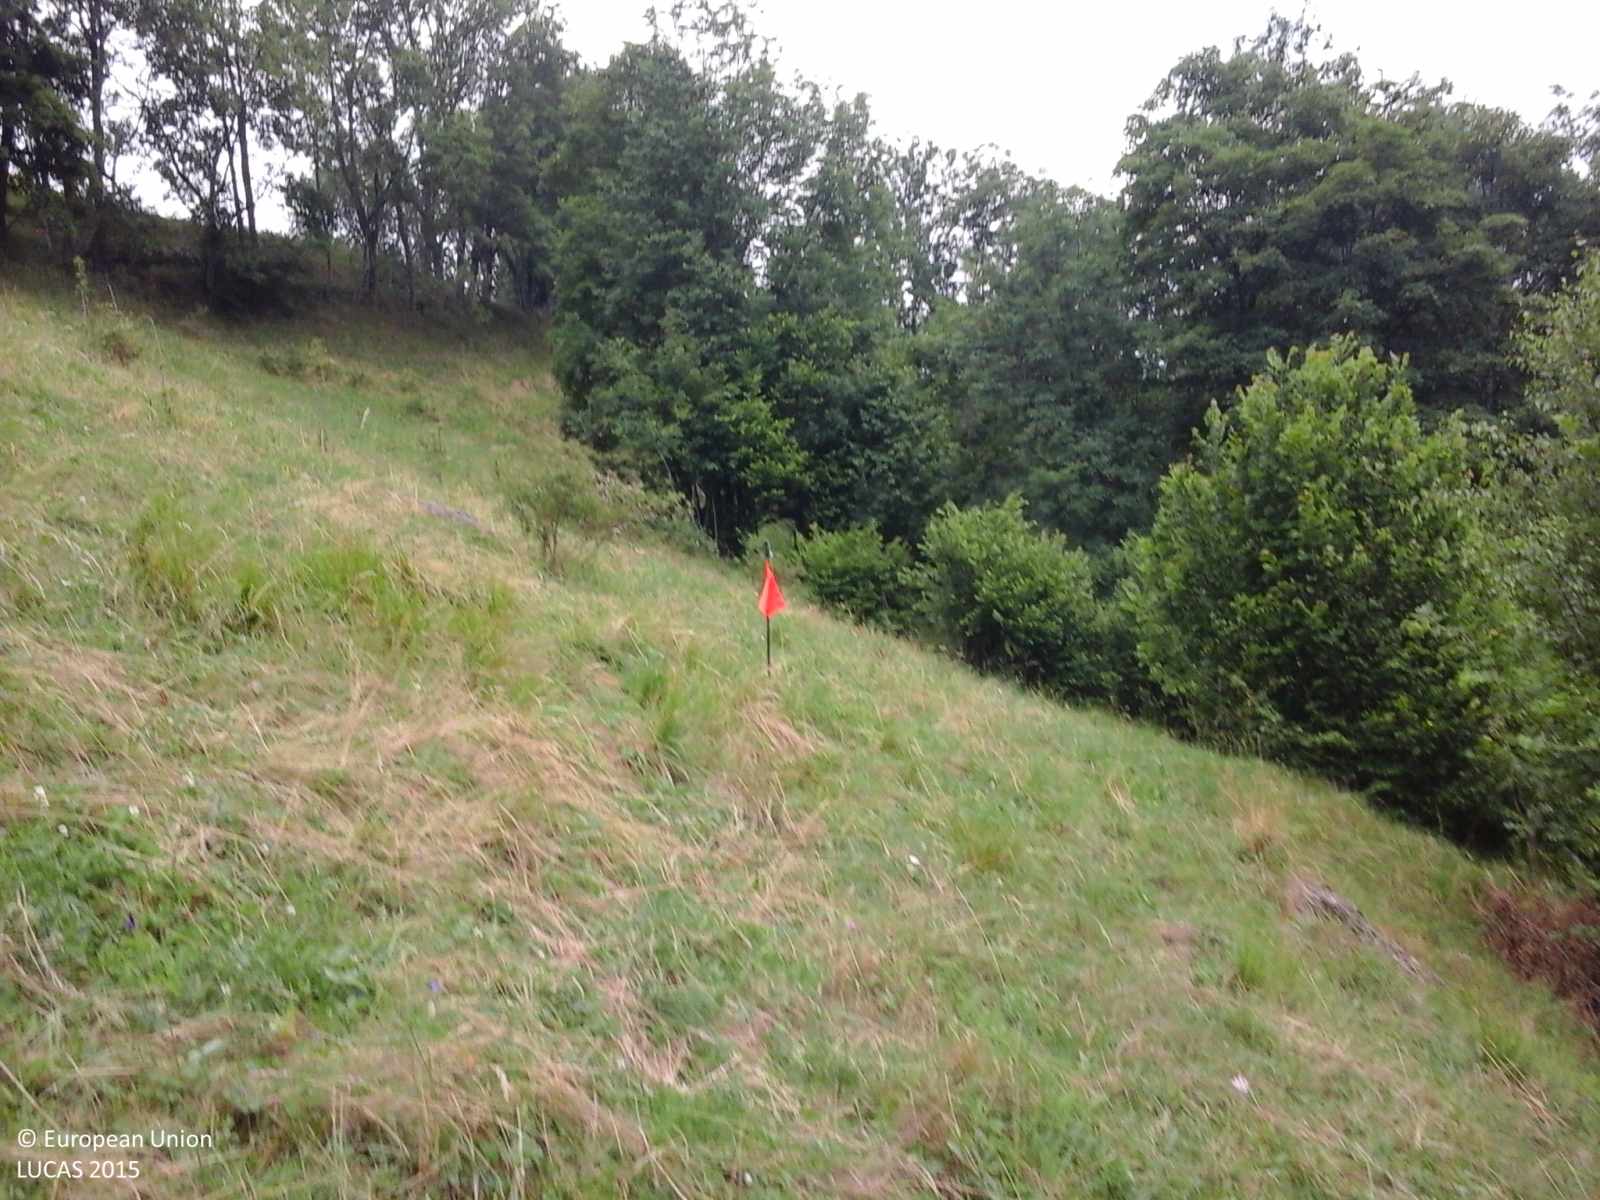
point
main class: Grassland
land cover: Grassland without tree/shrub cover
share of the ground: > 75 %
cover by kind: herbaceous plants 100 %
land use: Agriculture (excluding fallow land and kitchen gardens)
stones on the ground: 10 - 25 %
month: July
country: IT
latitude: 46.0627
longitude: 10.2453
